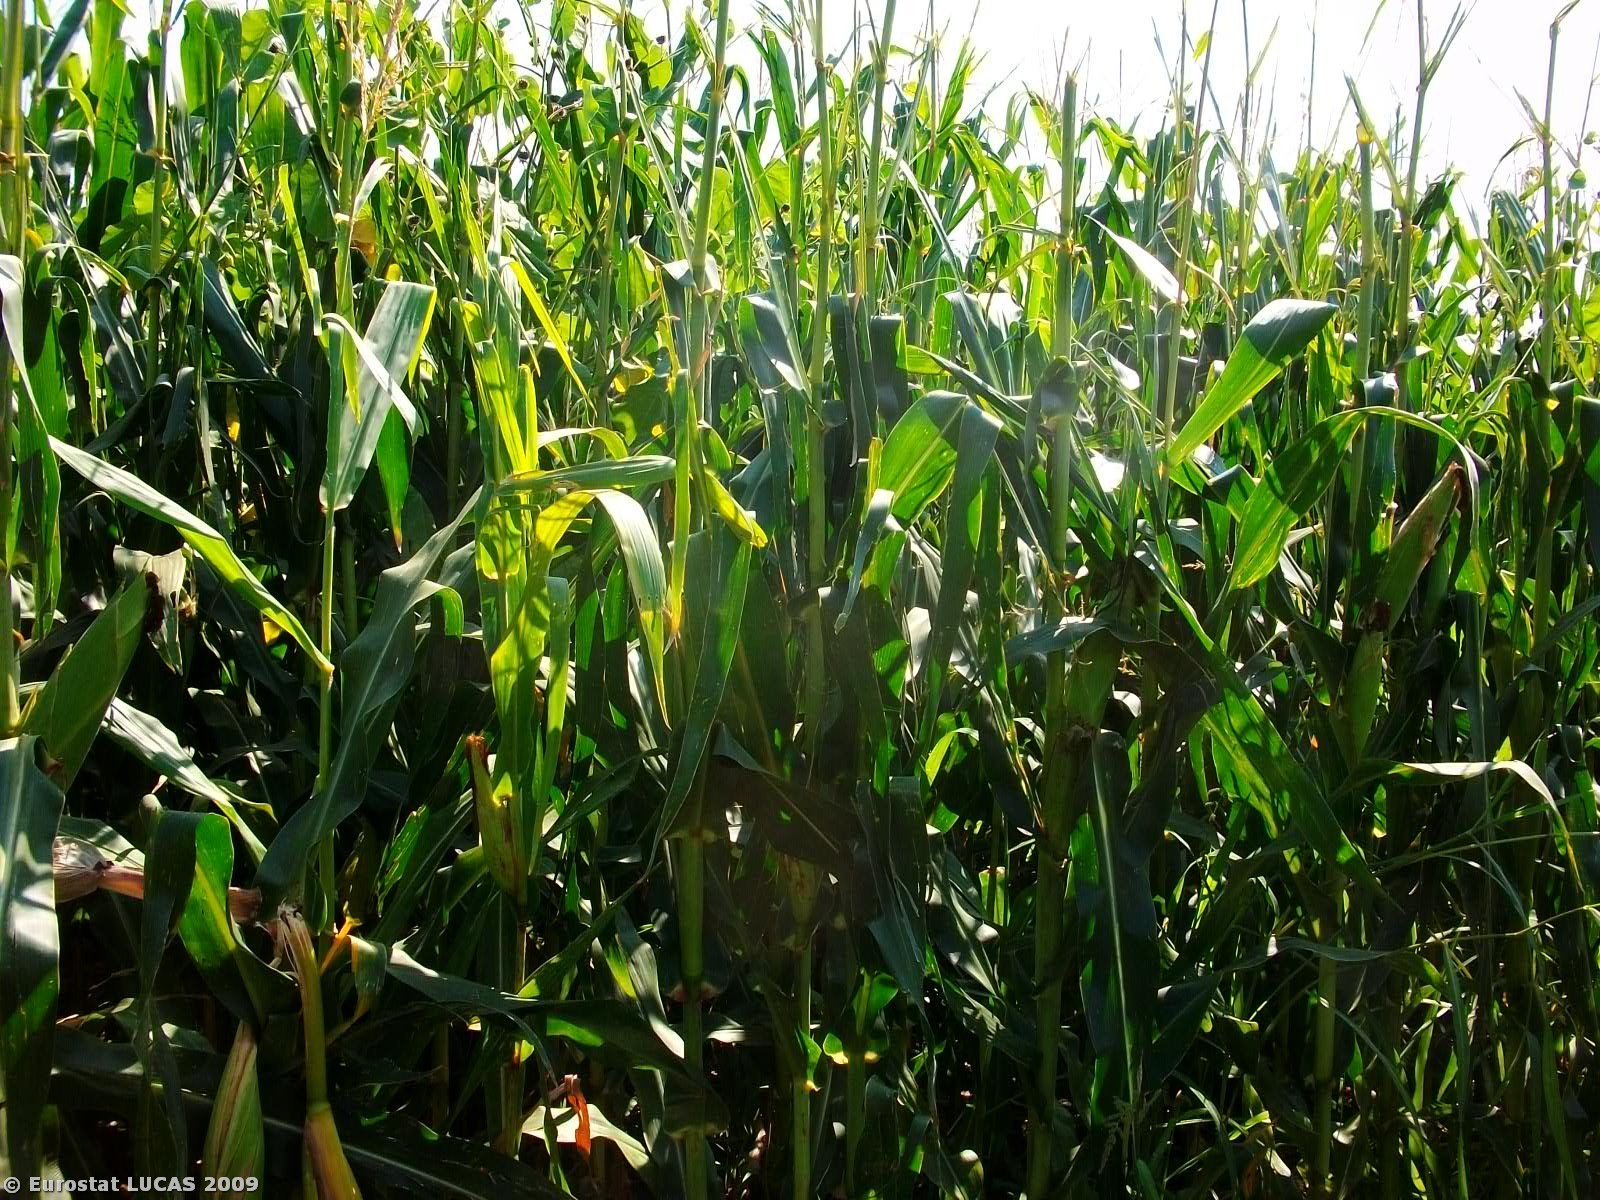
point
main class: Cropland
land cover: Maize
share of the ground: > 75 %
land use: Agriculture (excluding fallow land and kitchen gardens)
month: August
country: GR
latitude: 41.5215
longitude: 26.4350
